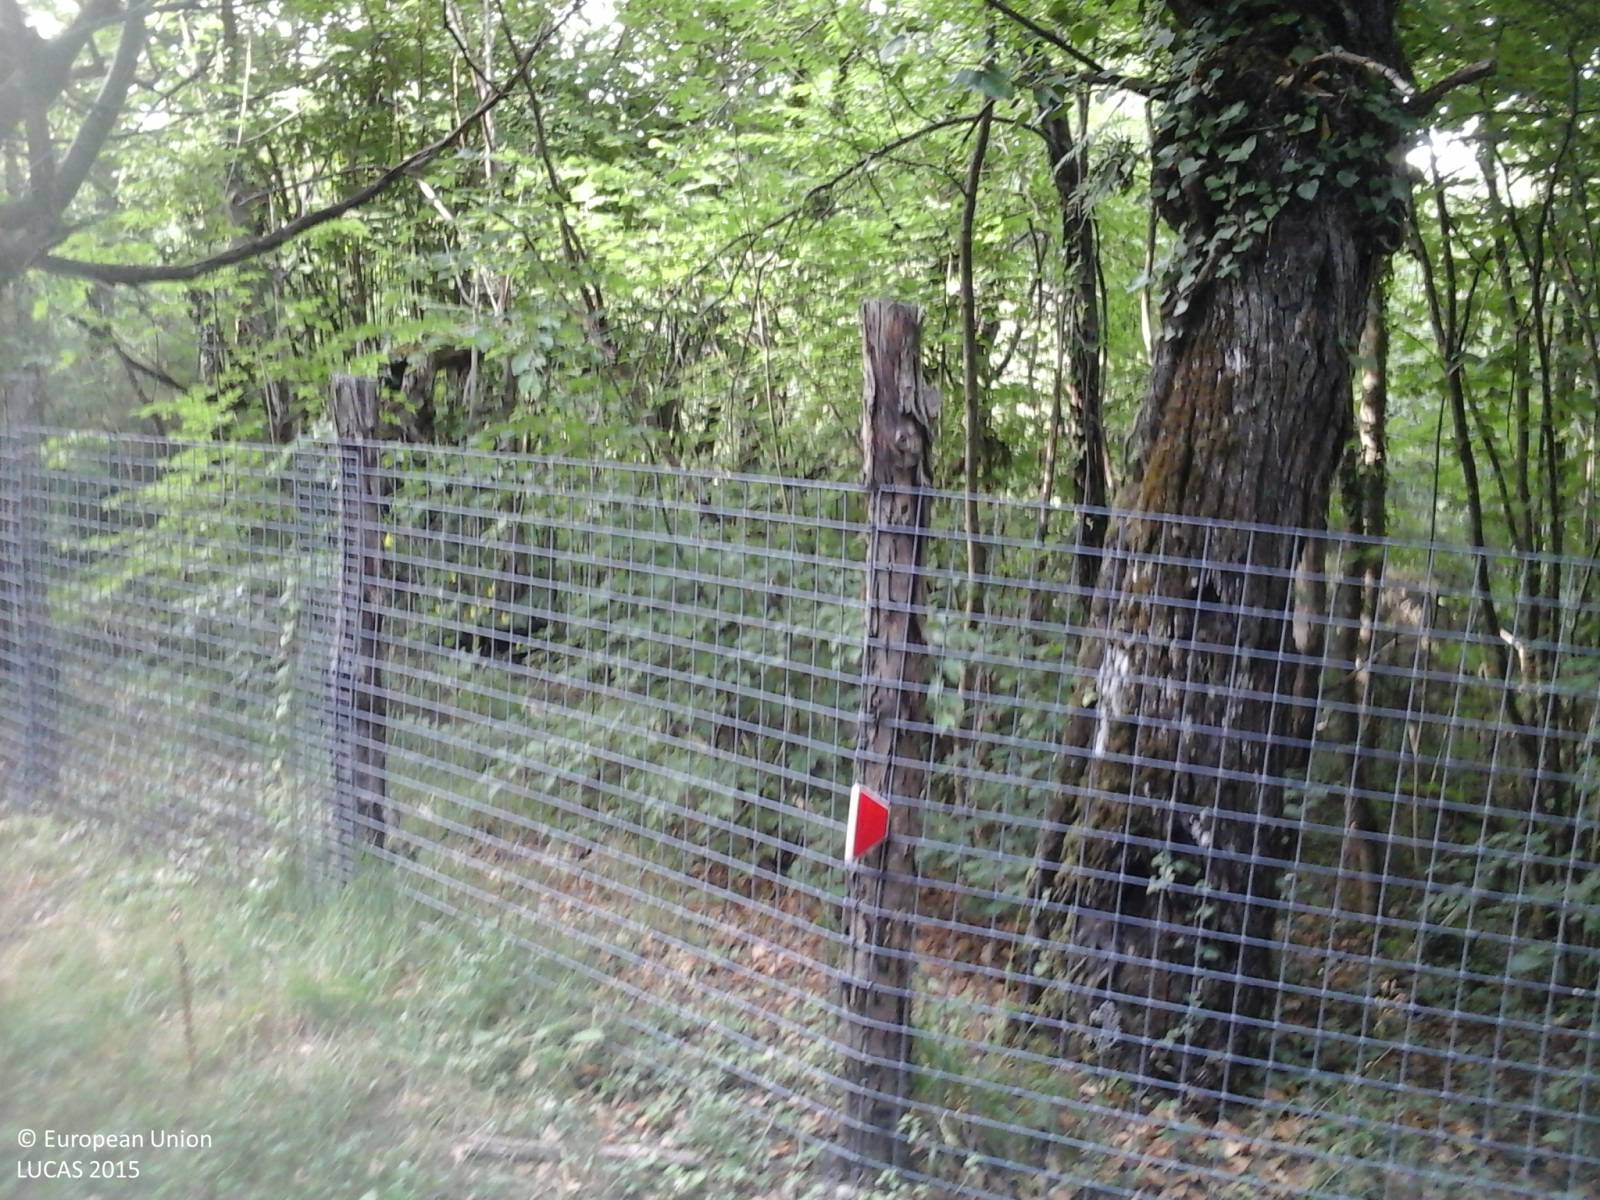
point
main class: Woodland
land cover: Broadleaved woodland
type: thermophilous deciduous forest
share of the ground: > 75 %
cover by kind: broadleaved forest trees 100 %
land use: Forestry
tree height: > 5 m
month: June
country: IT
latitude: 44.3685
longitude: 9.8623
